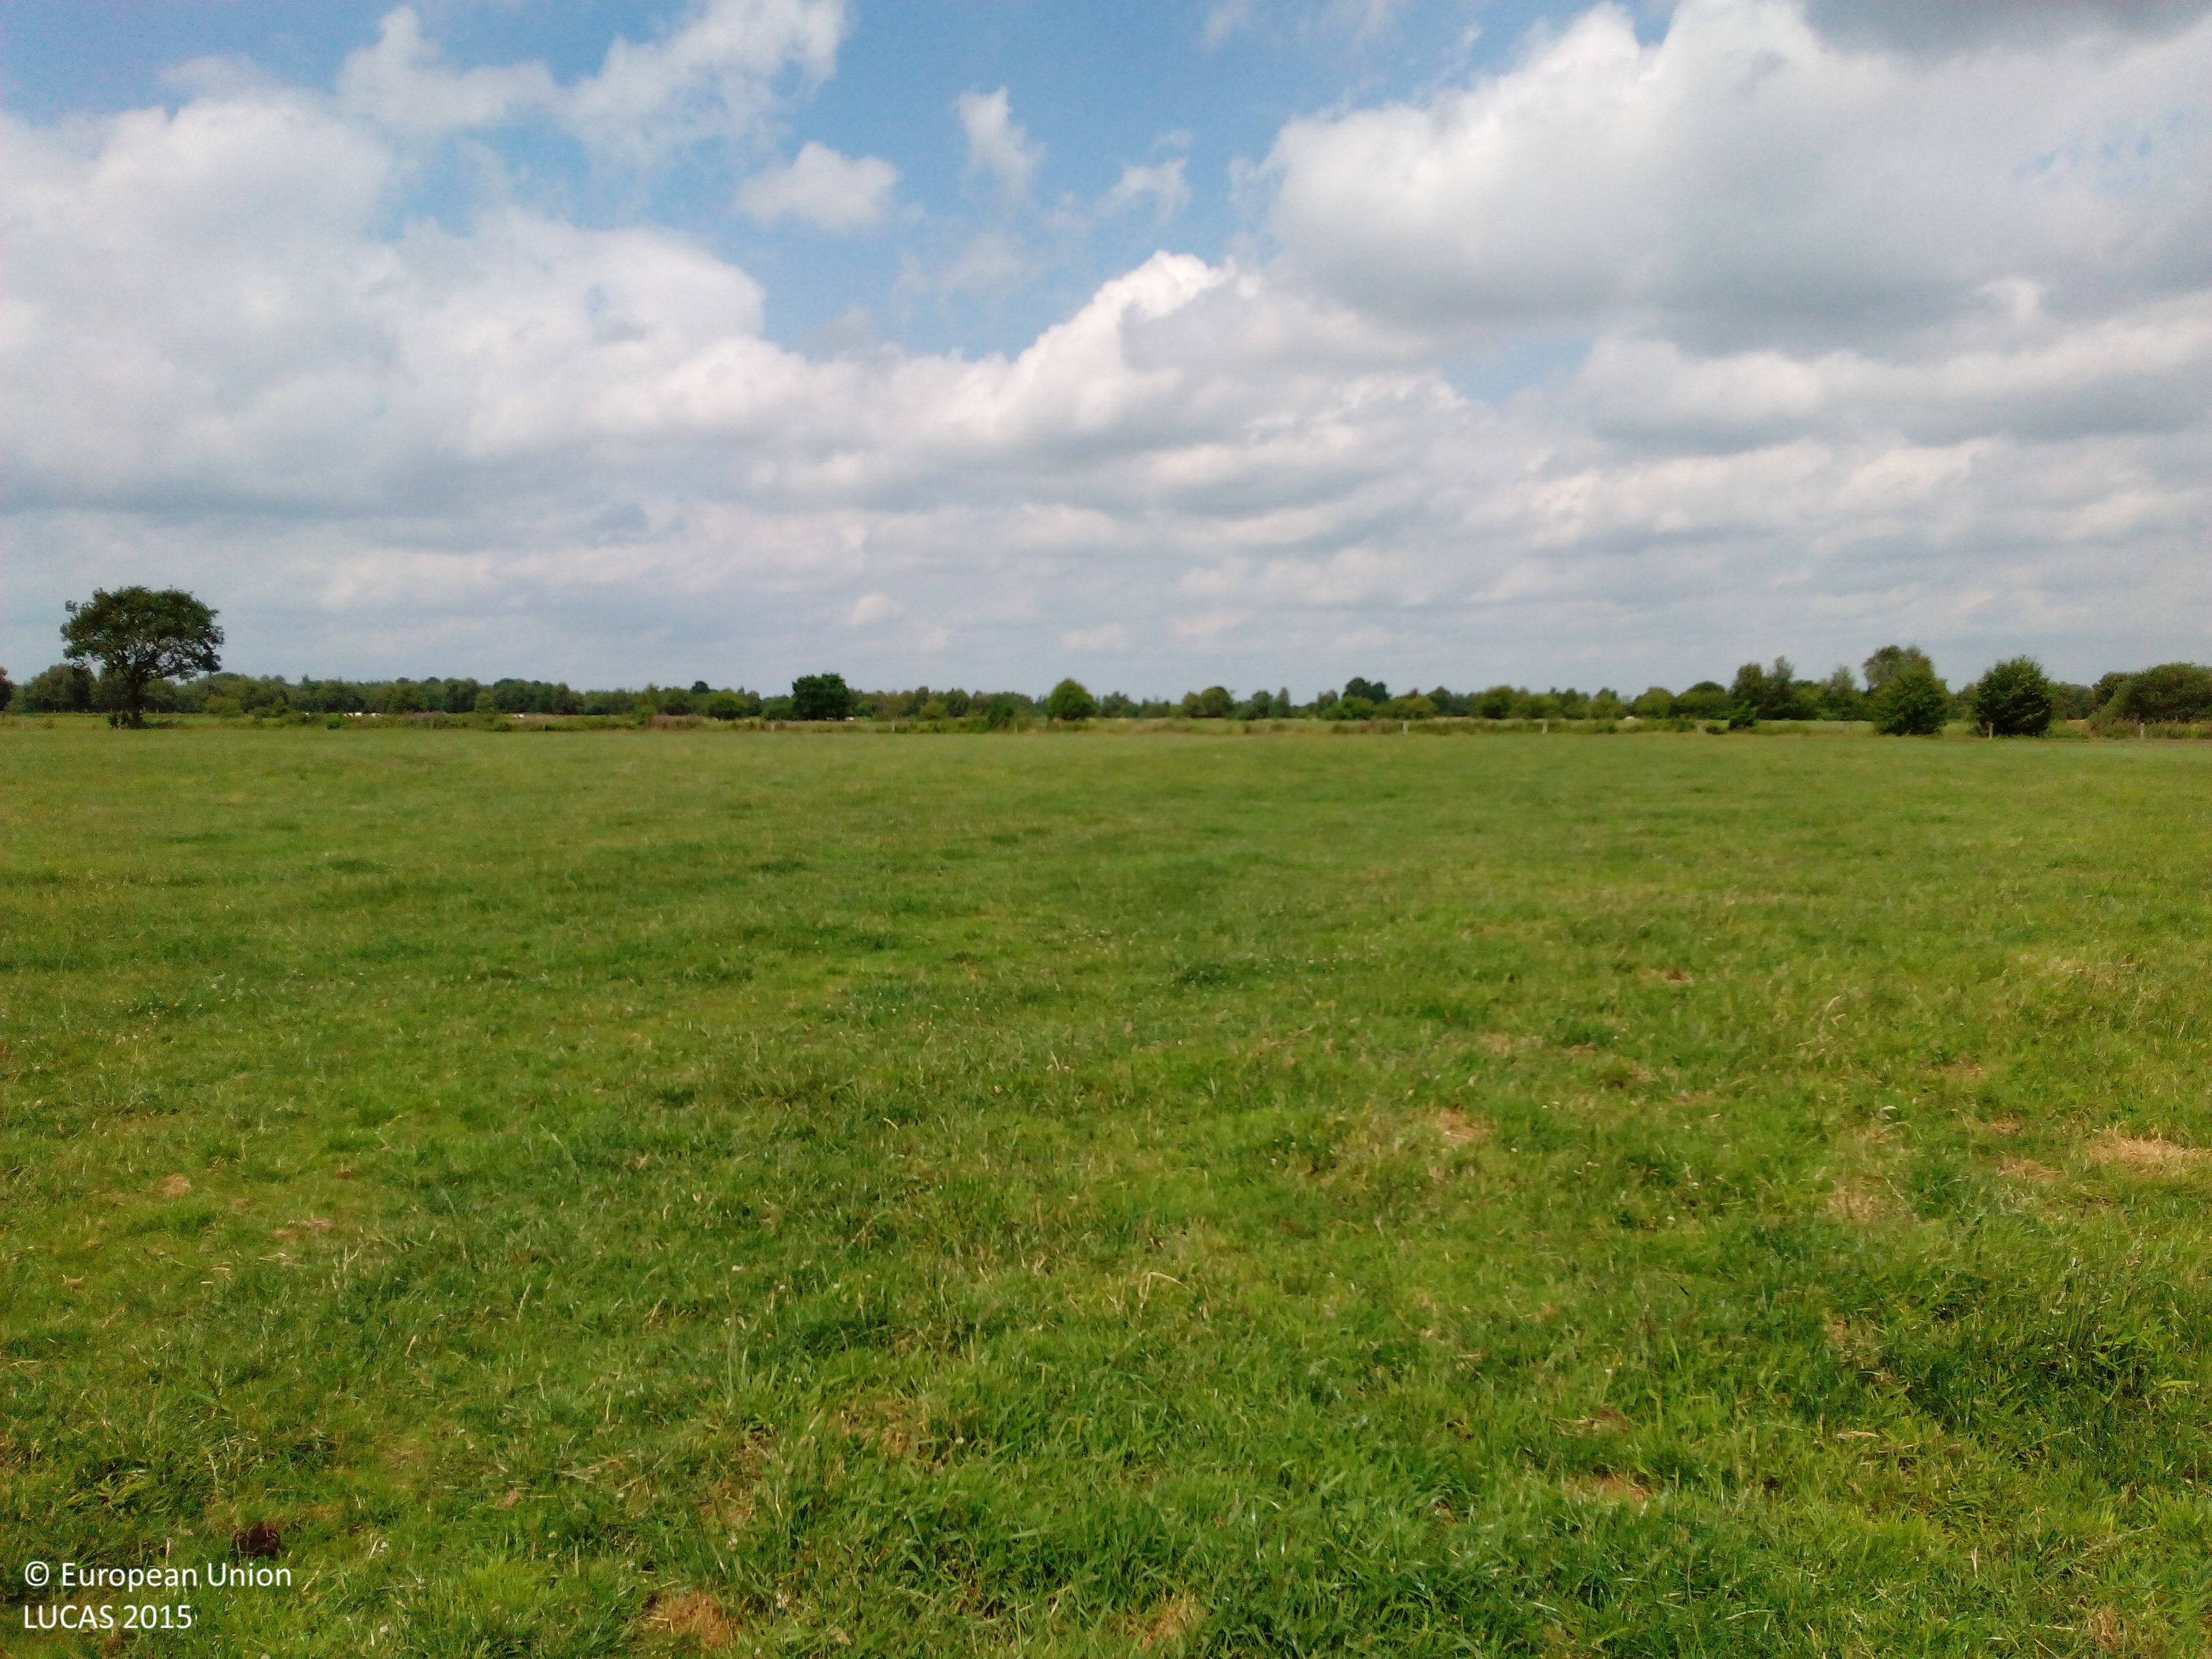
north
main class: Grassland
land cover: Grassland without tree/shrub cover
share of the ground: > 75 %
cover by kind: herbaceous plants 100 %
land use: Agriculture (excluding fallow land and kitchen gardens)
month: July
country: DE
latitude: 53.3115
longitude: 7.8844
